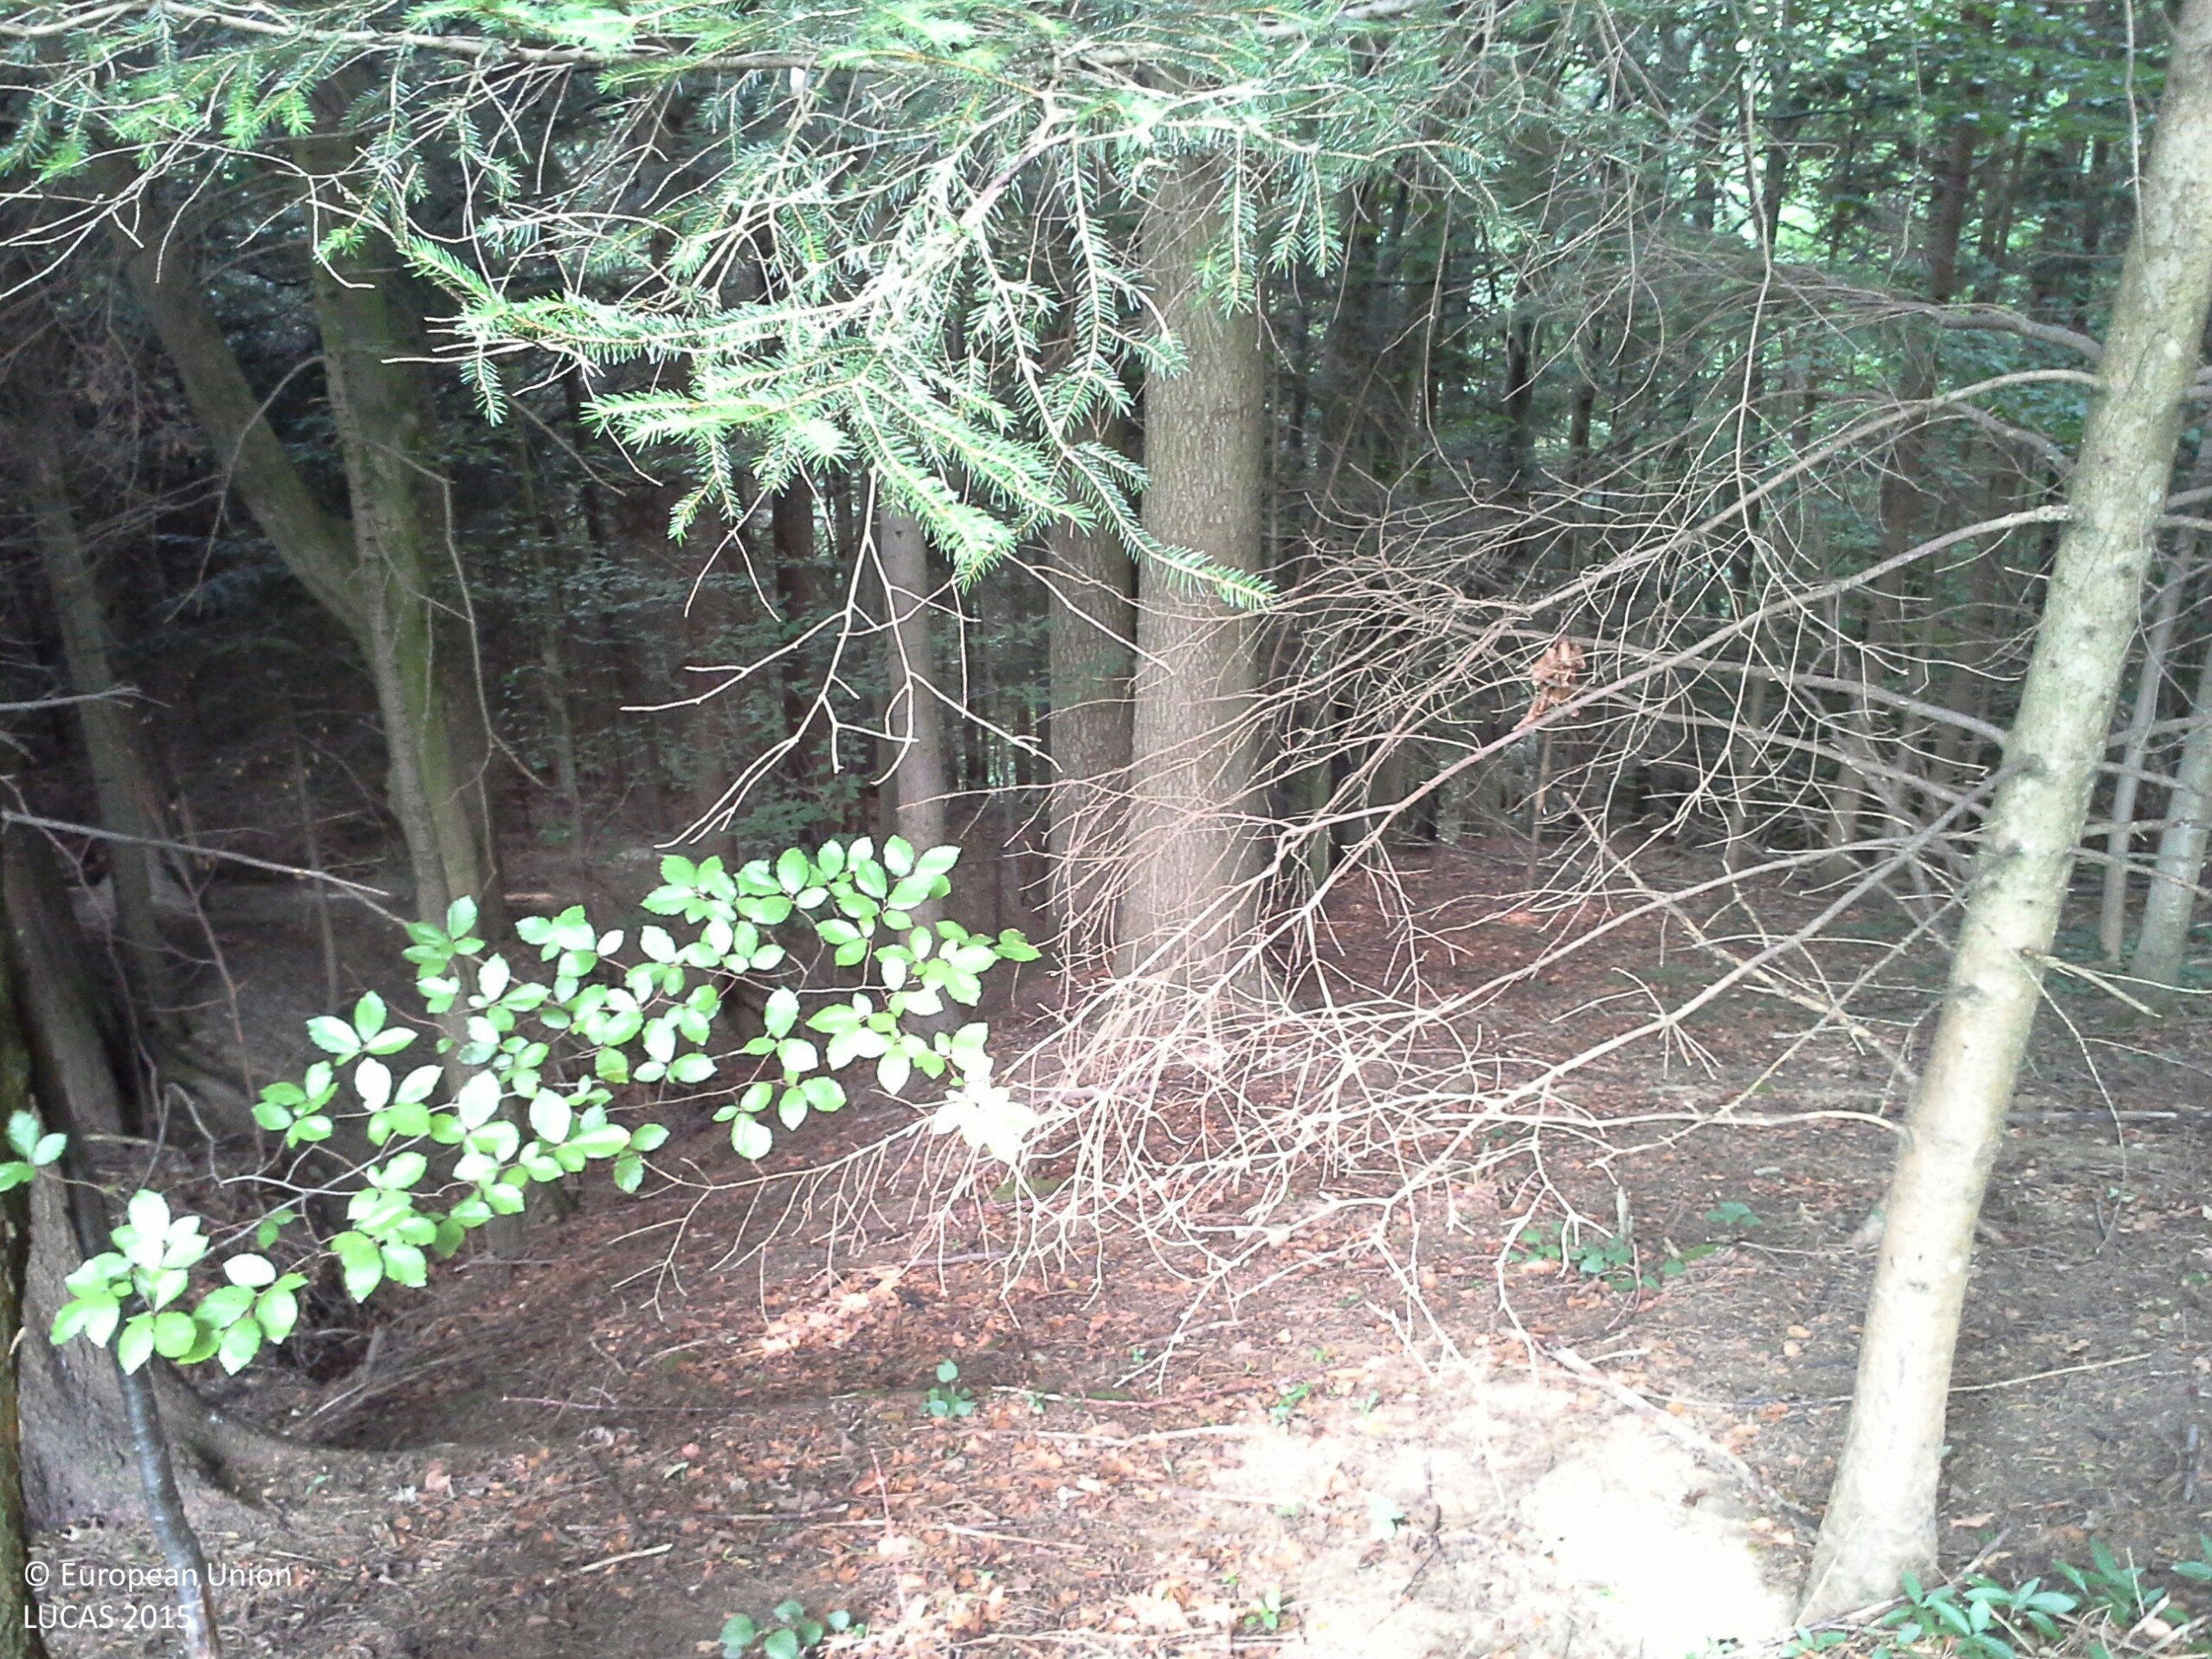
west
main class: Woodland
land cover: Spruce dominated mixed woodland
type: beech forest
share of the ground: > 75 %
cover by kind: coniferous forest trees 70 %, broadleaved forest trees 25 %, herbaceous plants 5 %
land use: Forestry
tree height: > 5 m
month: July
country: AT
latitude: 47.9847
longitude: 14.5690
